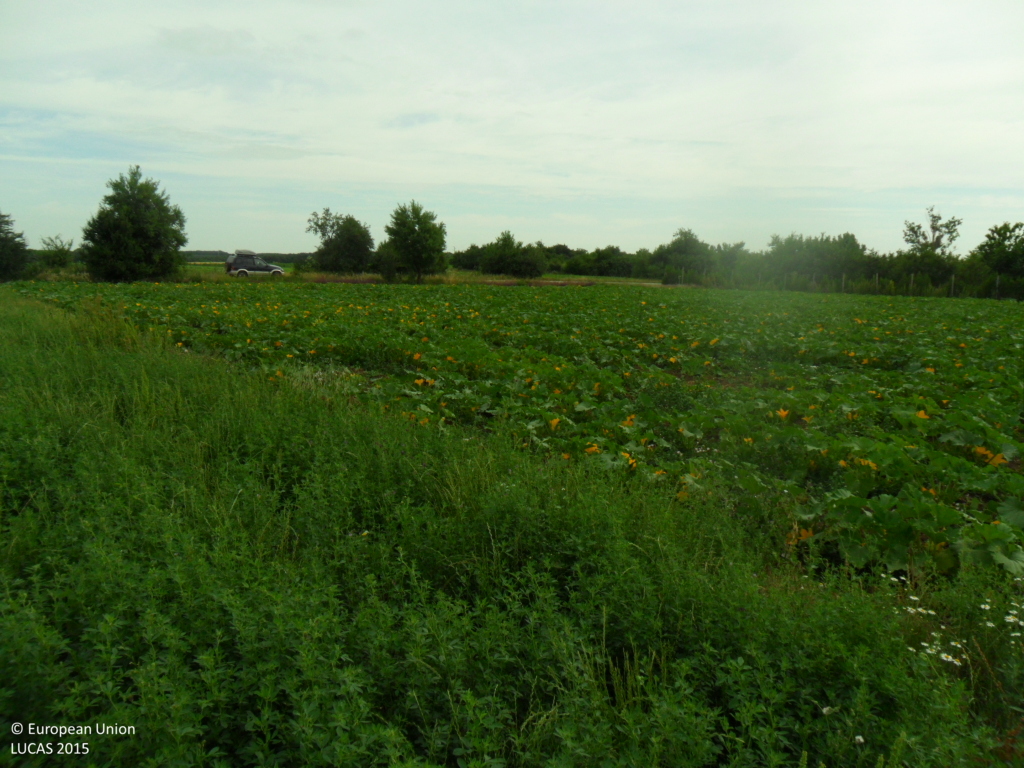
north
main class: Cropland
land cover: Lucerne
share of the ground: > 75 %
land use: Agriculture (excluding fallow land and kitchen gardens)
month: June
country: BG
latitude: 43.7011
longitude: 26.9319
